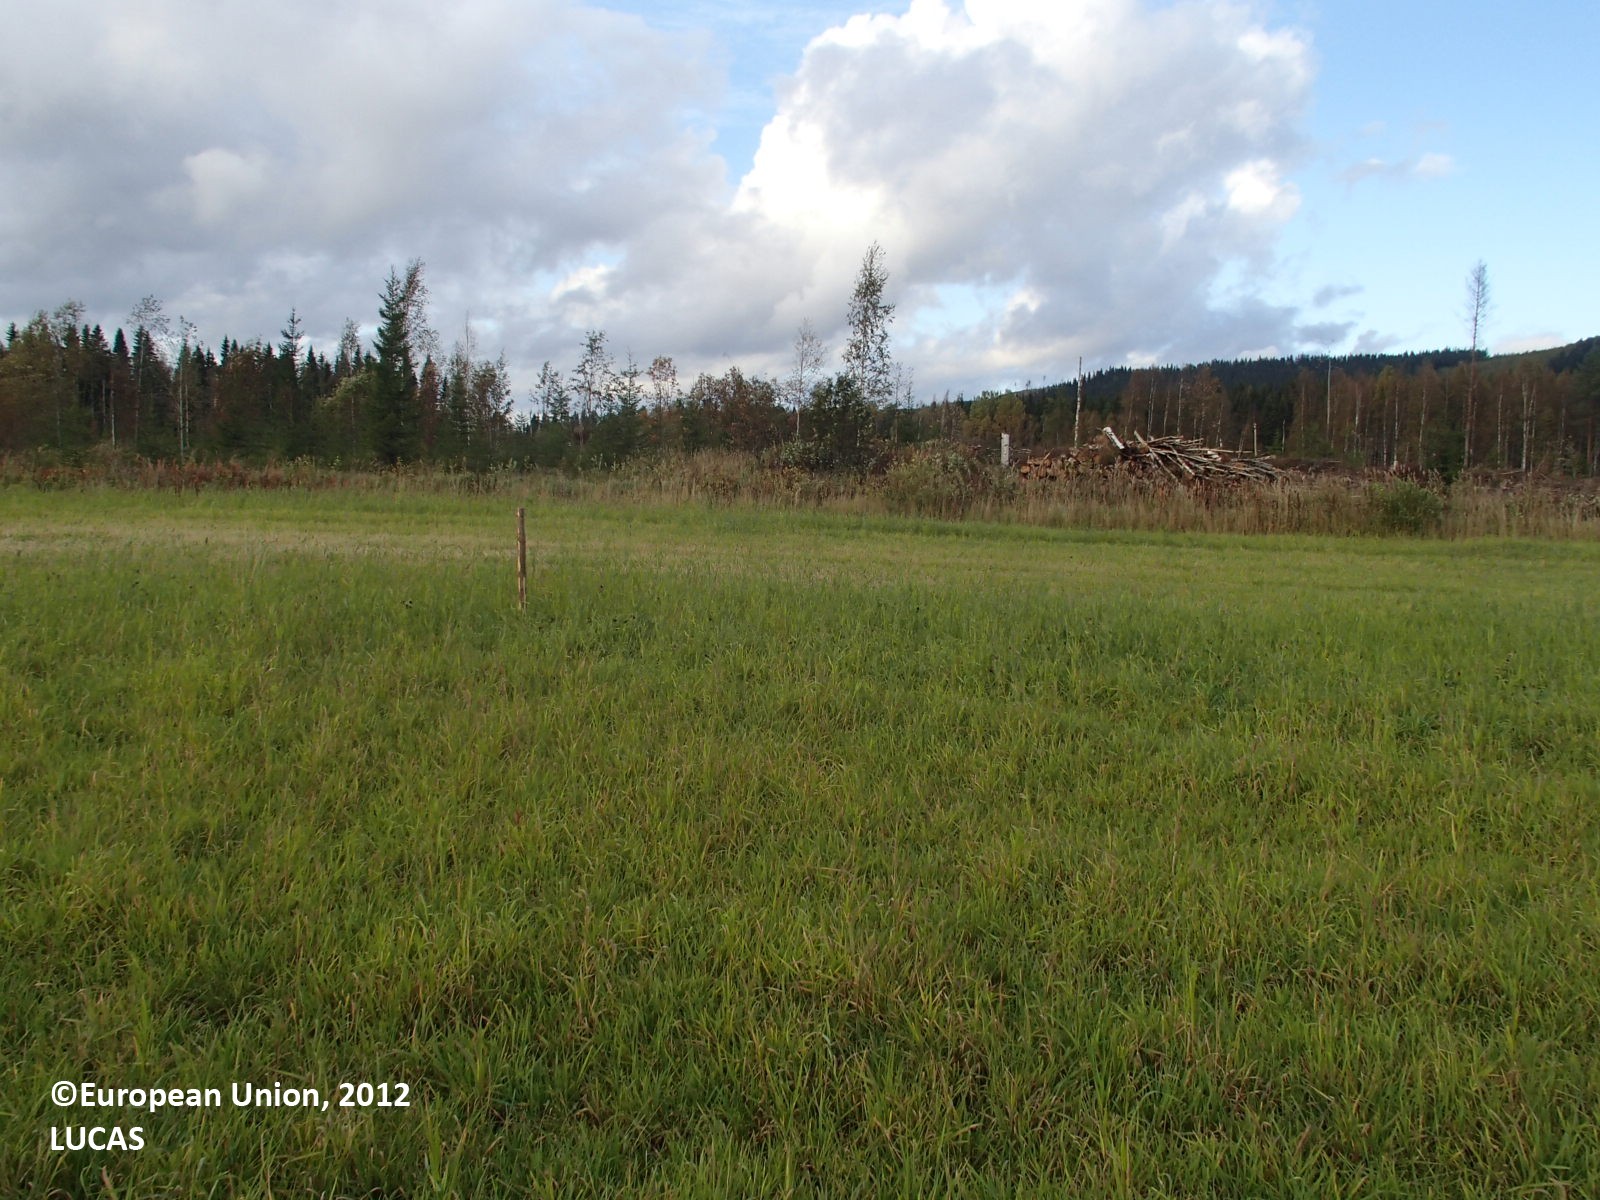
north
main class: Cropland
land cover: Temporary grasslands
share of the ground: > 75 %
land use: Agriculture (excluding fallow land and kitchen gardens)
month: September
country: FI
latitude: 63.3047
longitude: 27.9498
